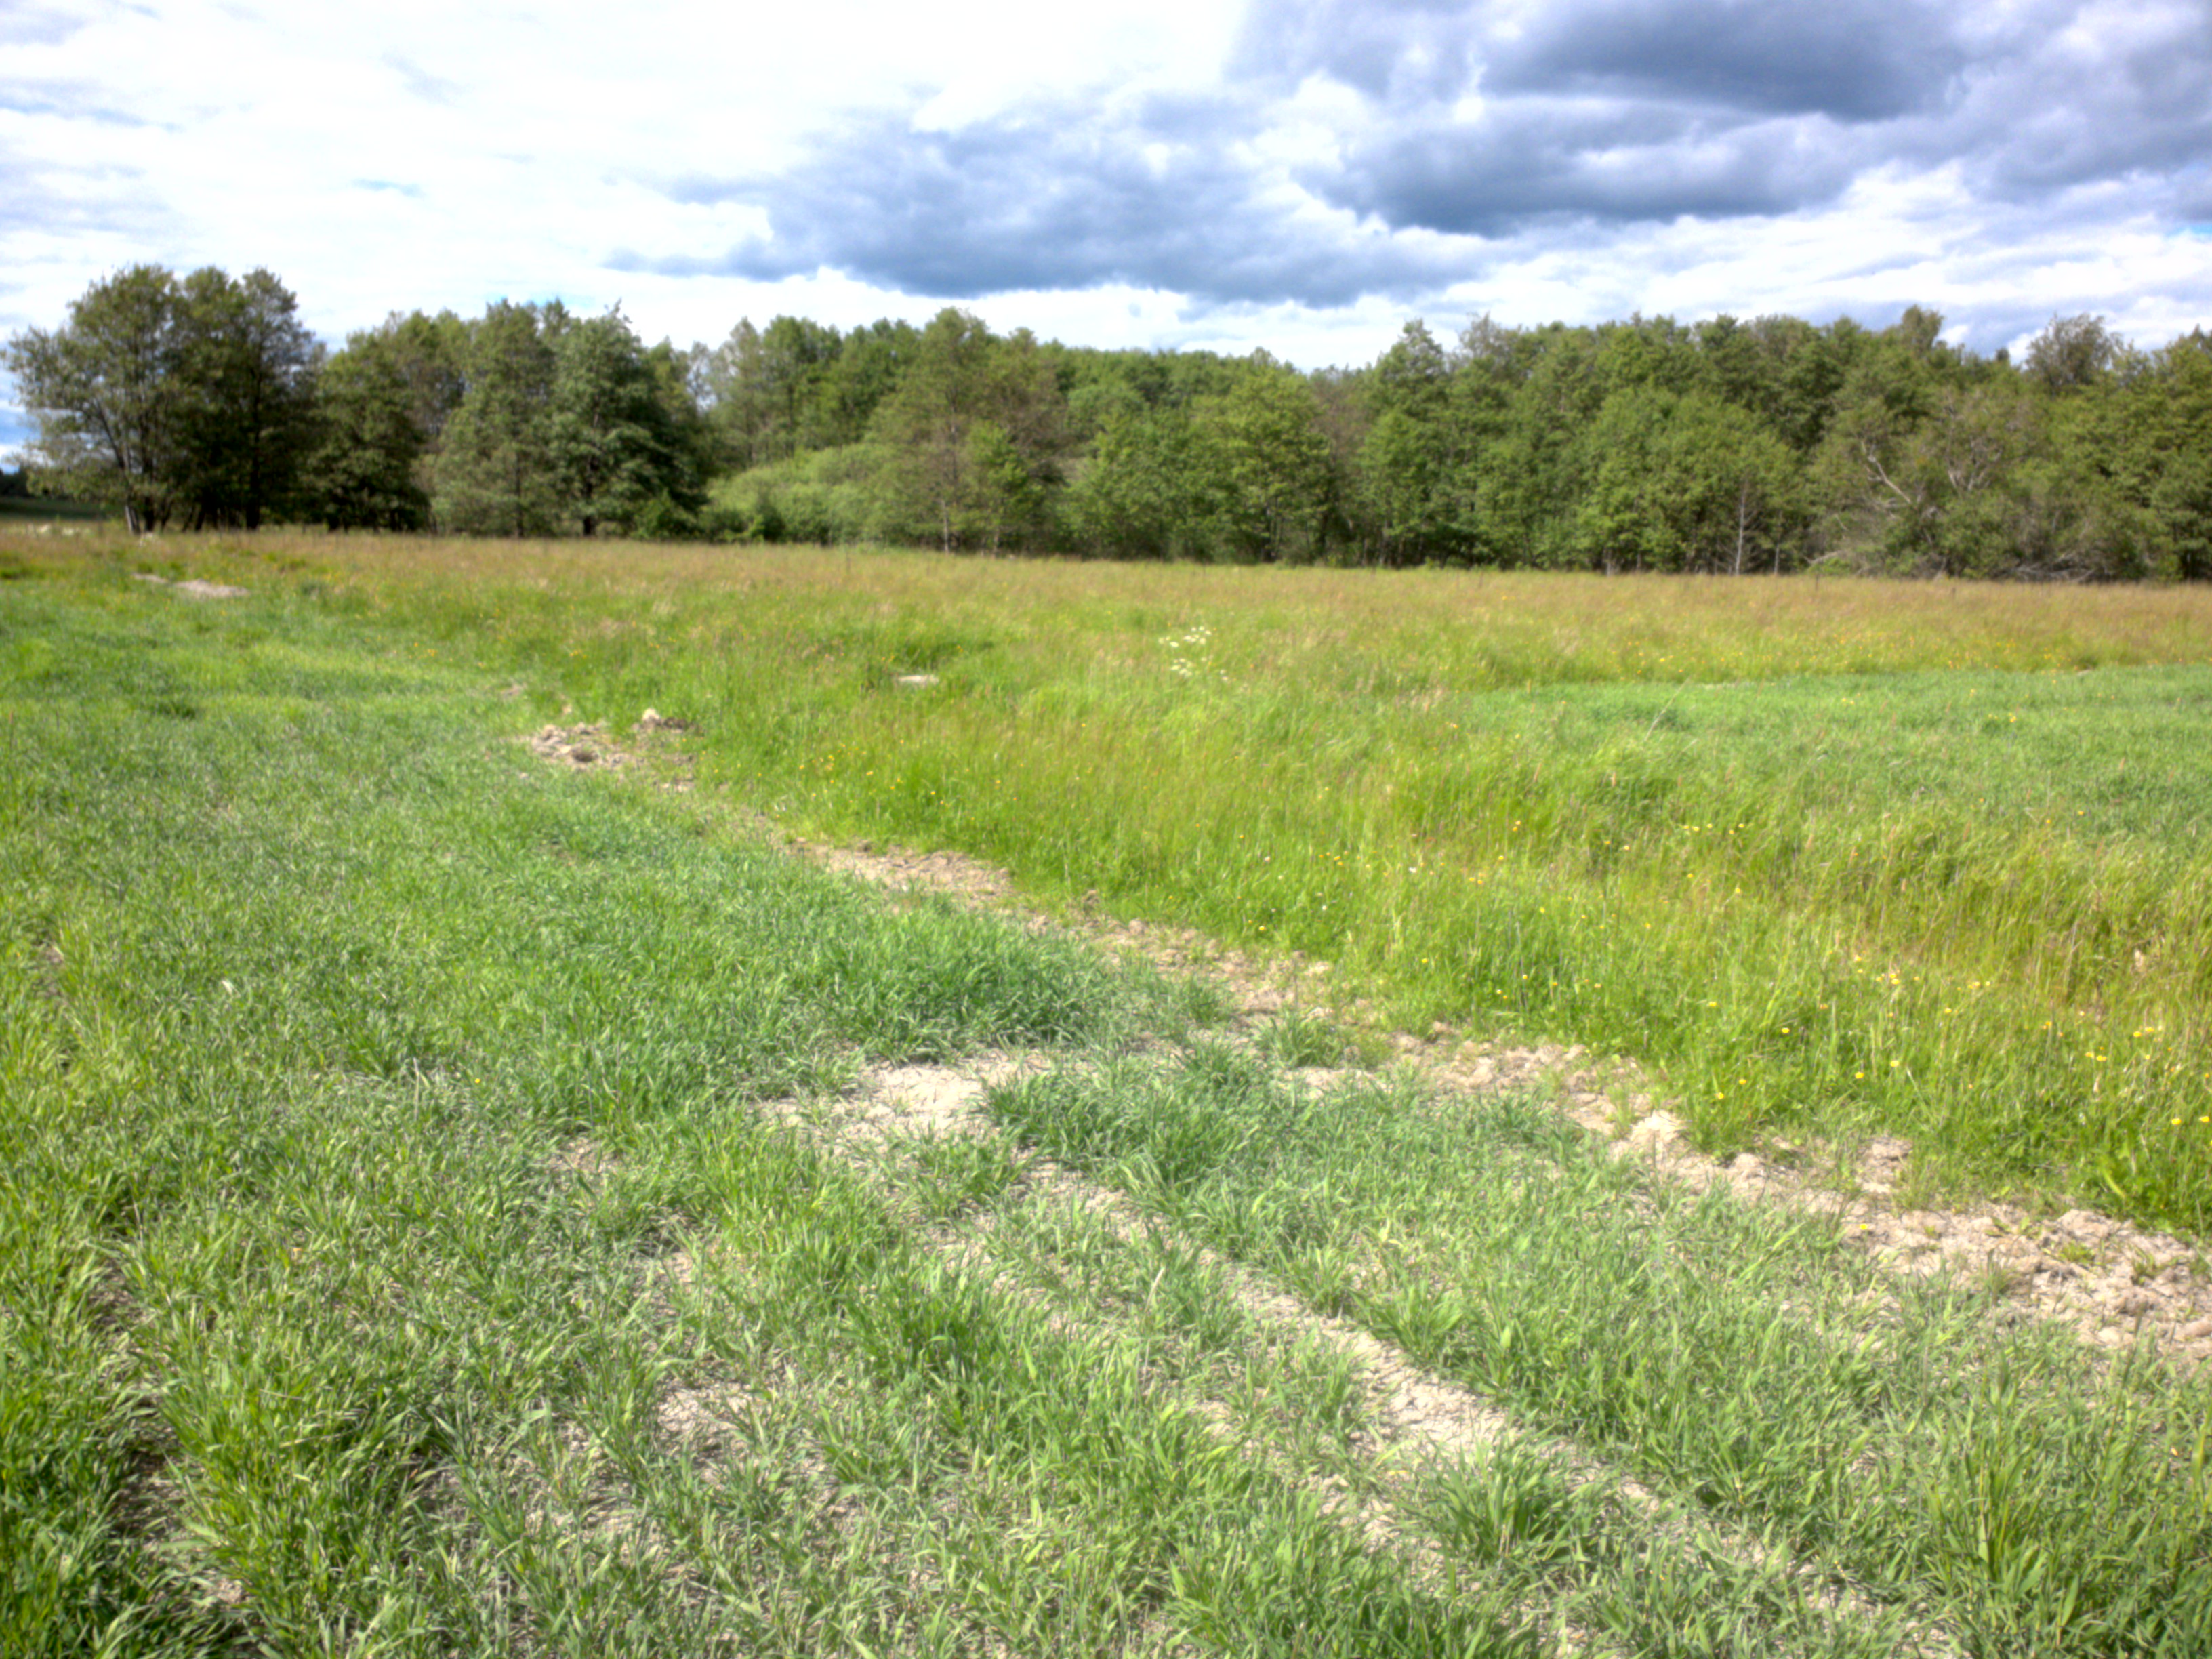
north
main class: Cropland
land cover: Barley
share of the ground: > 75 %
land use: Agriculture (excluding fallow land and kitchen gardens)
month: June
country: SE
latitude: 59.4095
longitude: 17.6953
